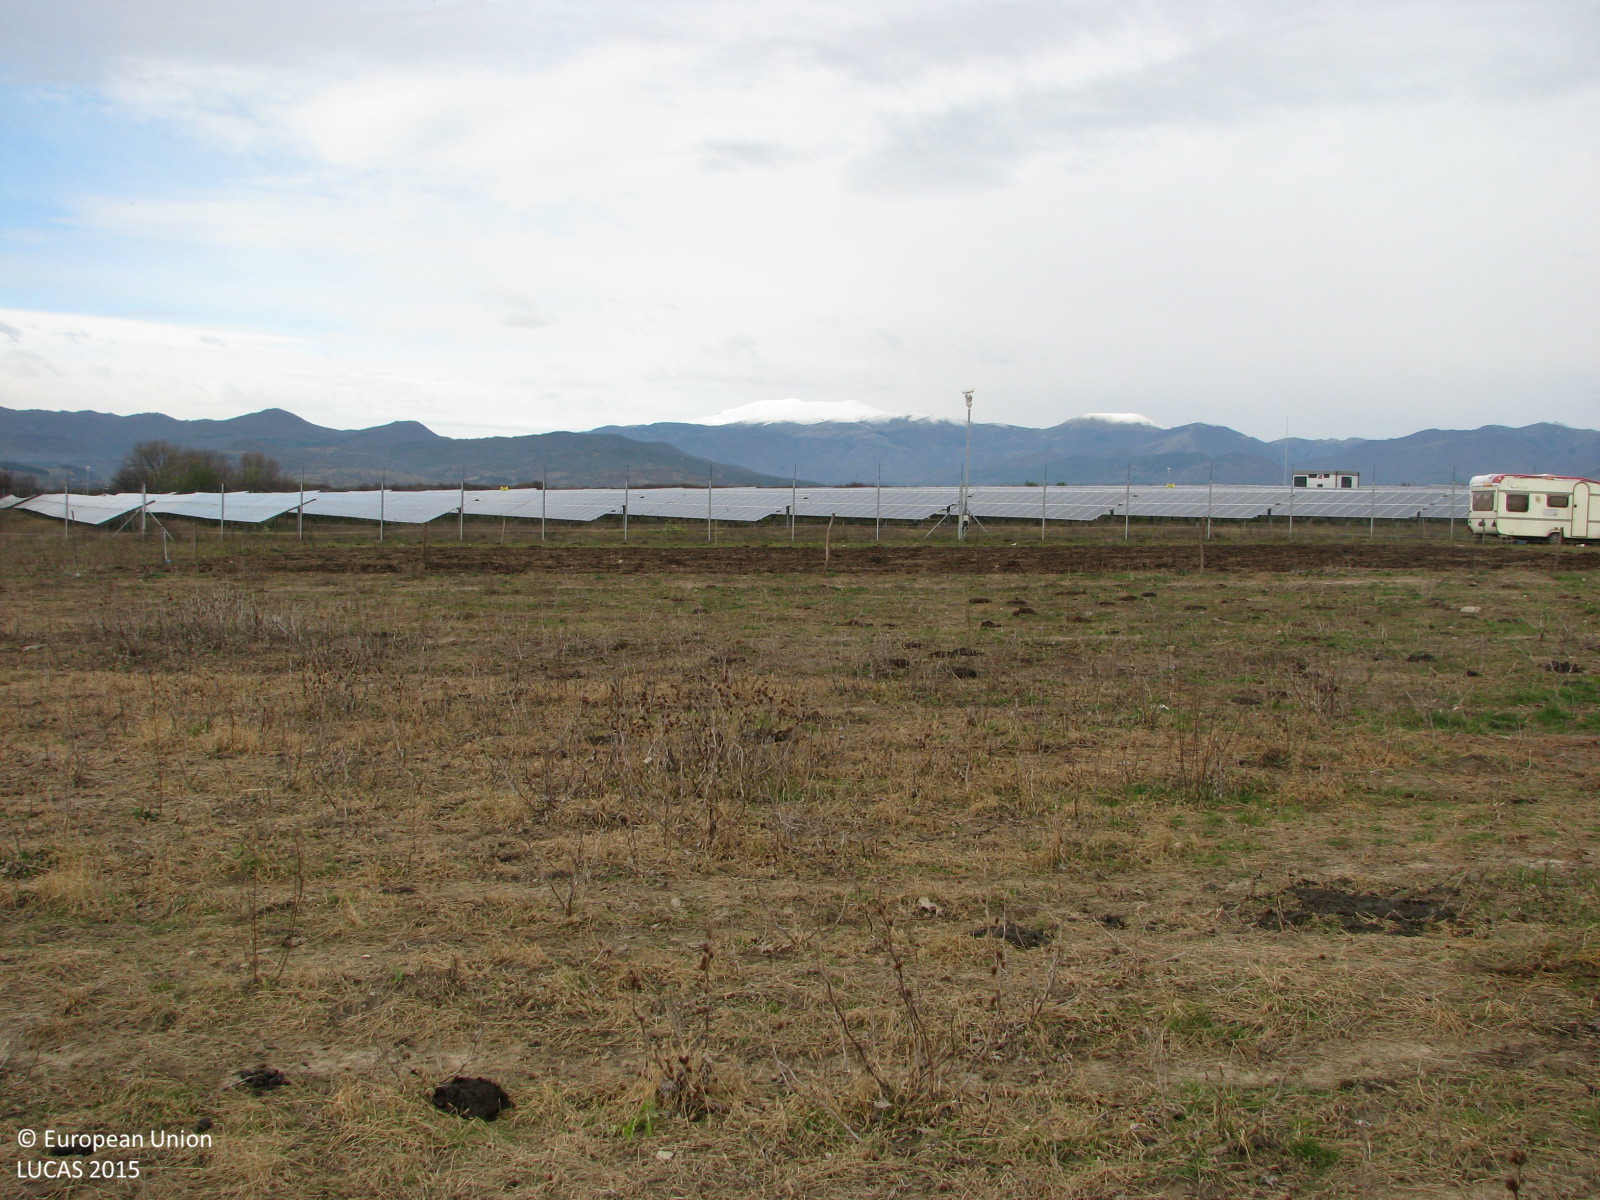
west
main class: Grassland
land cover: Spontaneously vegetated surfaces
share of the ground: 50 - 75 %
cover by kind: herbaceous plants 70 %, unconsolidated bare surface 30 %
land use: Agriculture (excluding fallow land and kitchen gardens)
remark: Harvested field
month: December
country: BG
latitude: 42.6372
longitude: 24.7027
